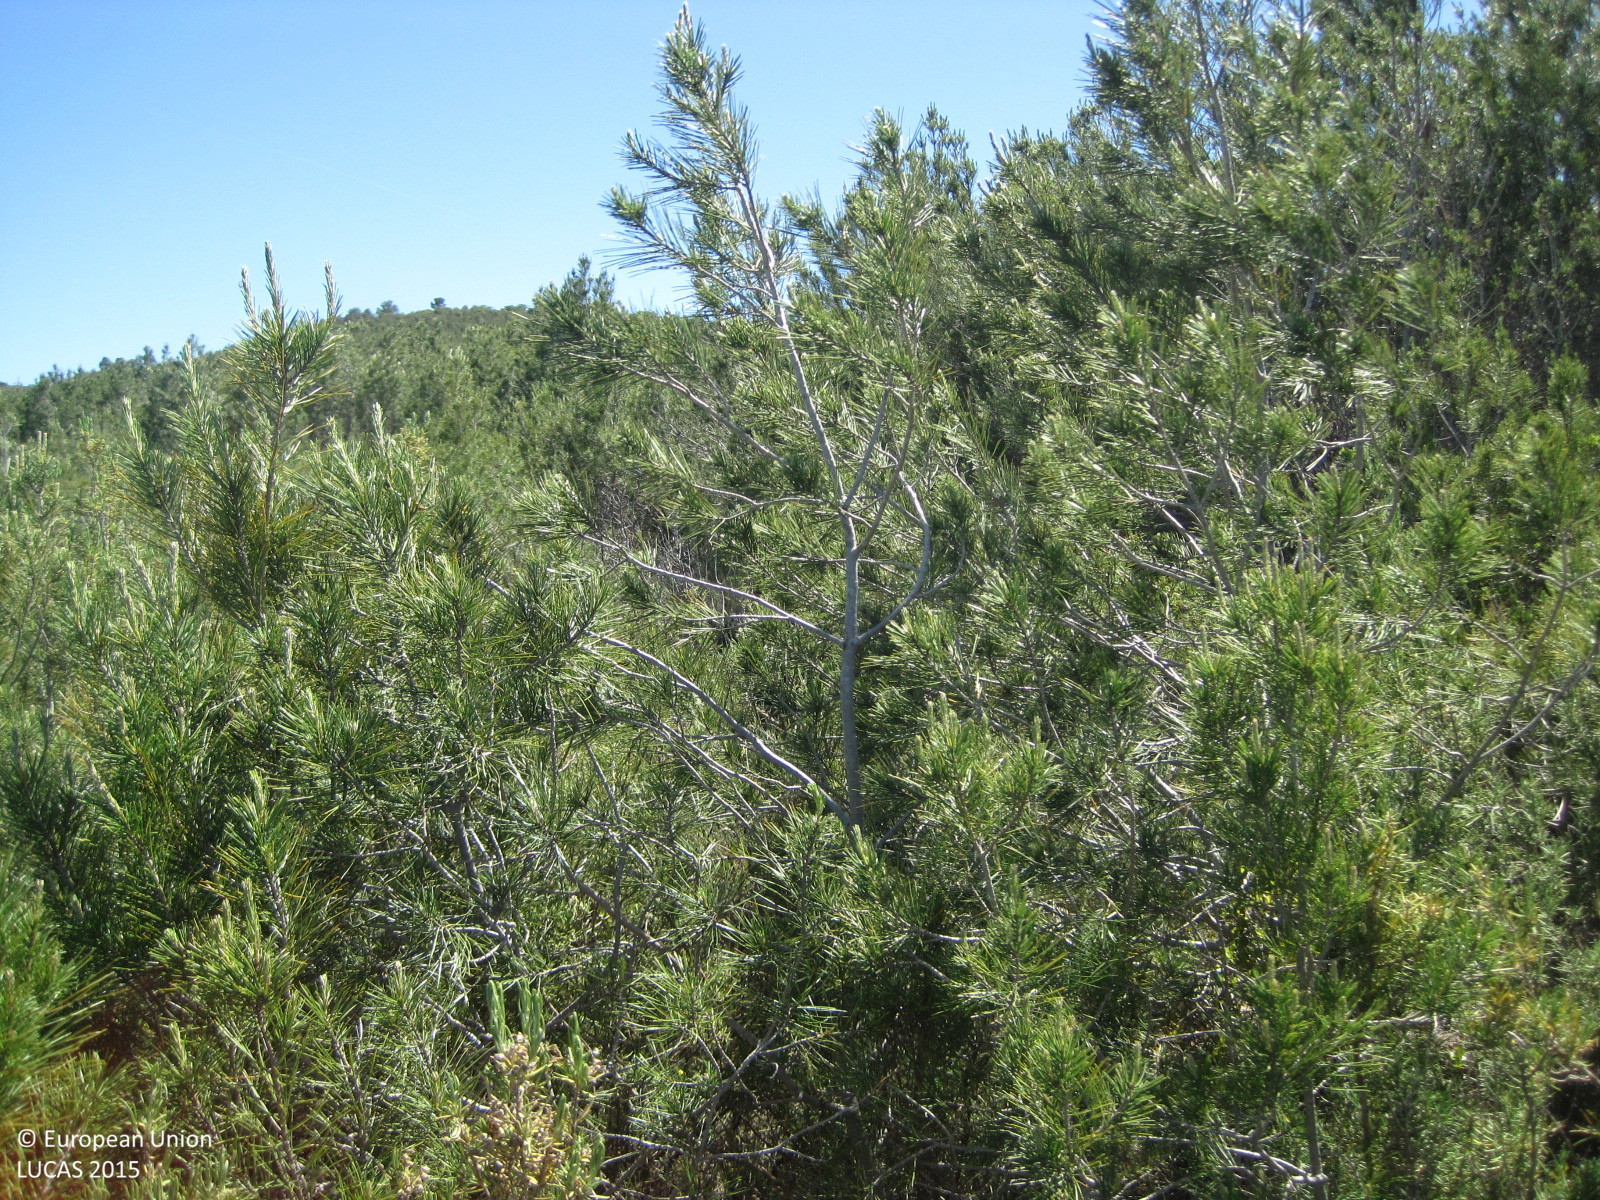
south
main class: Woodland
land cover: Pine dominated coniferous woodland
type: coniferous forest of the mediterranean region
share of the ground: > 75 %
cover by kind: coniferous forest trees 90 %, shrubs 10 %
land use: Forestry
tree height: < 5 m
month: May
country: ES
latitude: 39.3814
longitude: -1.0868
